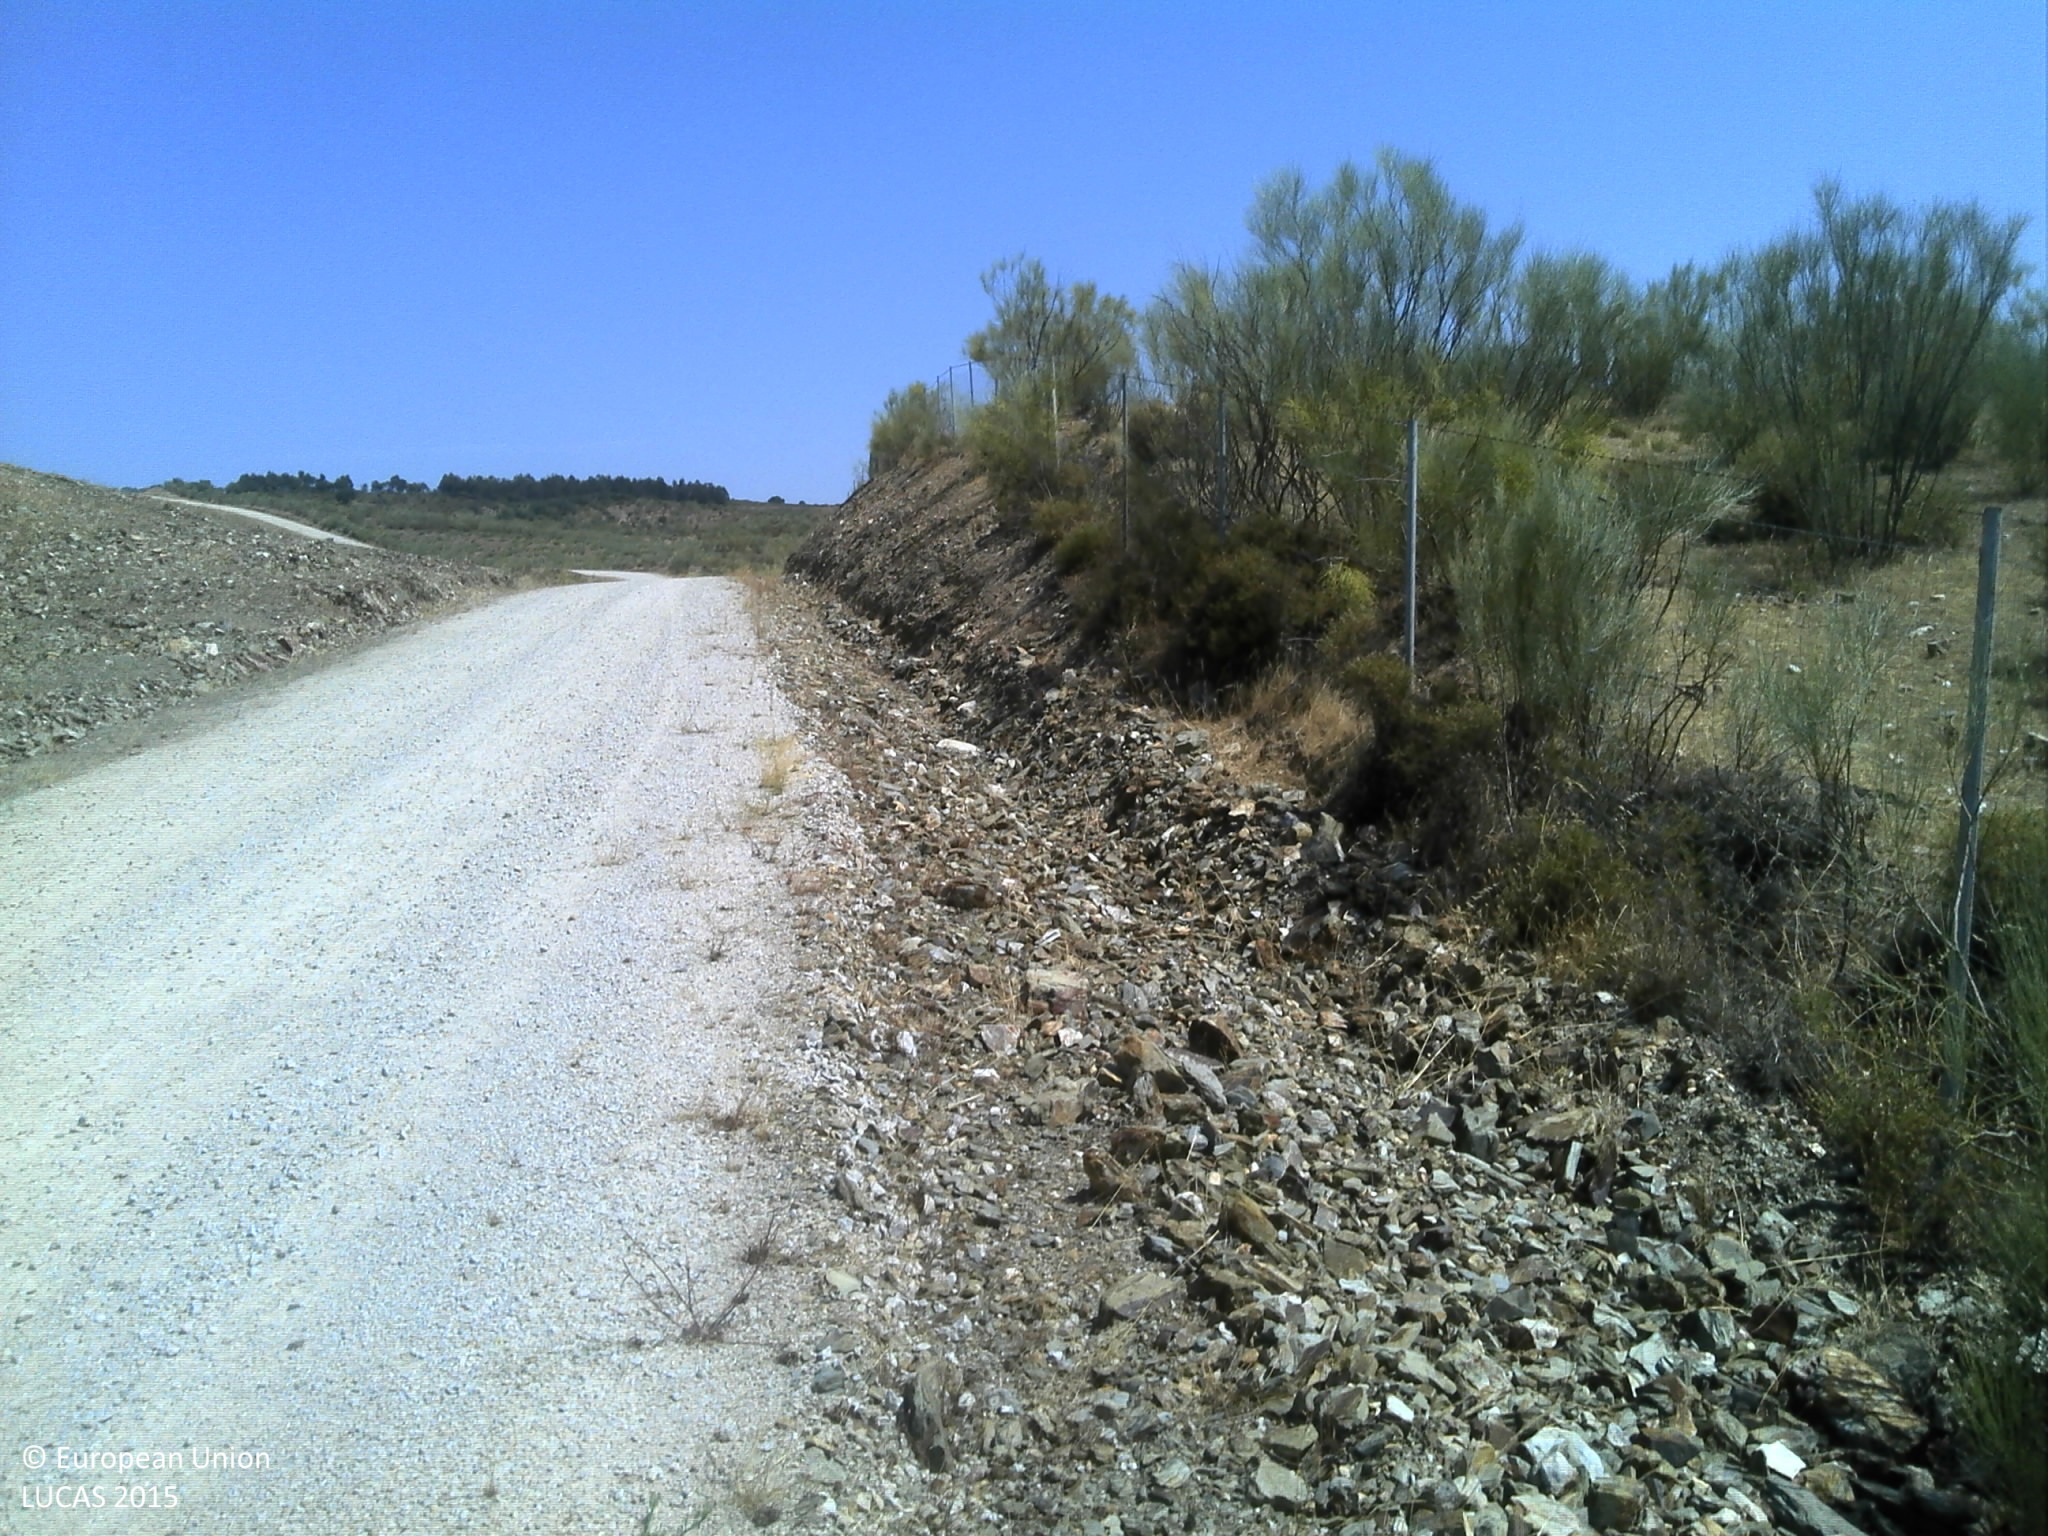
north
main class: Shrubland
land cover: Shrubland with sparse tree cover
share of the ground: 50 - 75 %
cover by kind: shrubs 65 %, herbaceous plants 30 %, broadleaved forest trees 5 %
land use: Abandoned areas
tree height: < 5 m
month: June
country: PT
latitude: 39.7236
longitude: -7.0378
